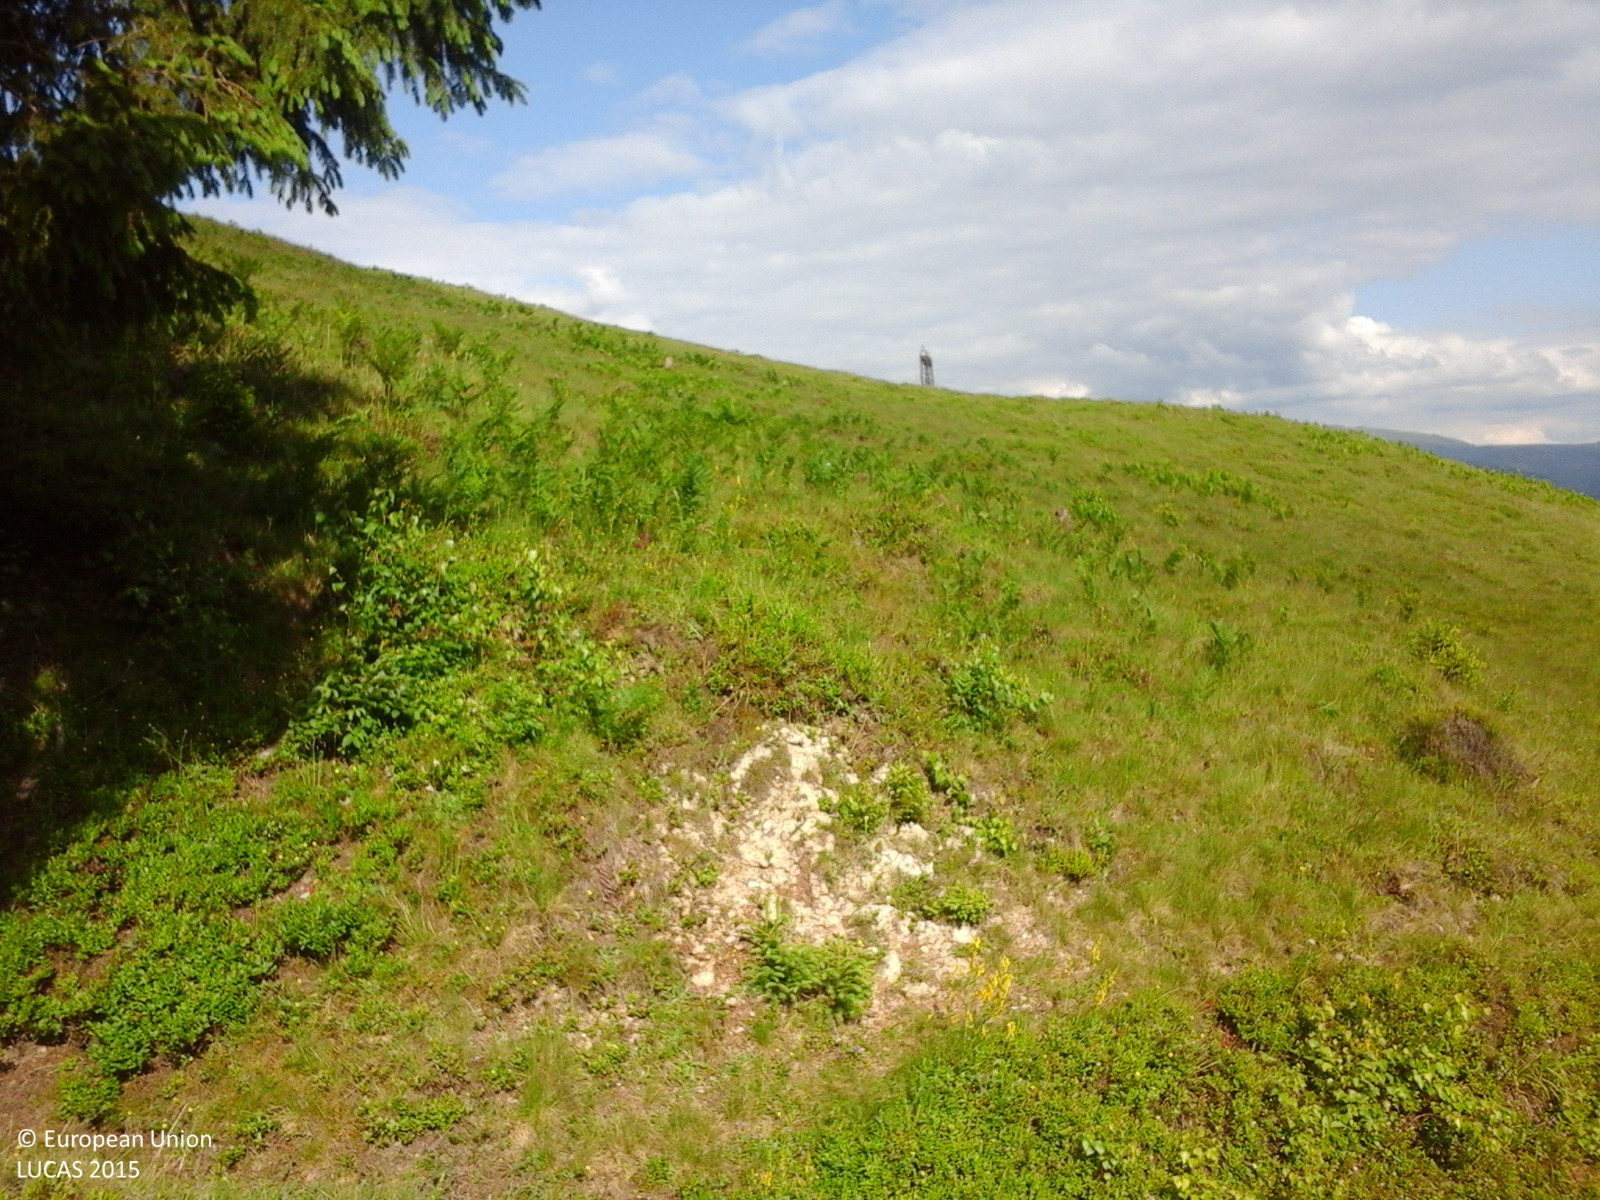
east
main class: Grassland
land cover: Grassland without tree/shrub cover
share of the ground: > 75 %
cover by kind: herbaceous plants 100 %
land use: Agriculture (excluding fallow land and kitchen gardens)
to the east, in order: Grassland without tree/shrub cover; Electric lines; Grassland without tree/shrub cover
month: June
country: RO
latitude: 47.4901
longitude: 25.3359
